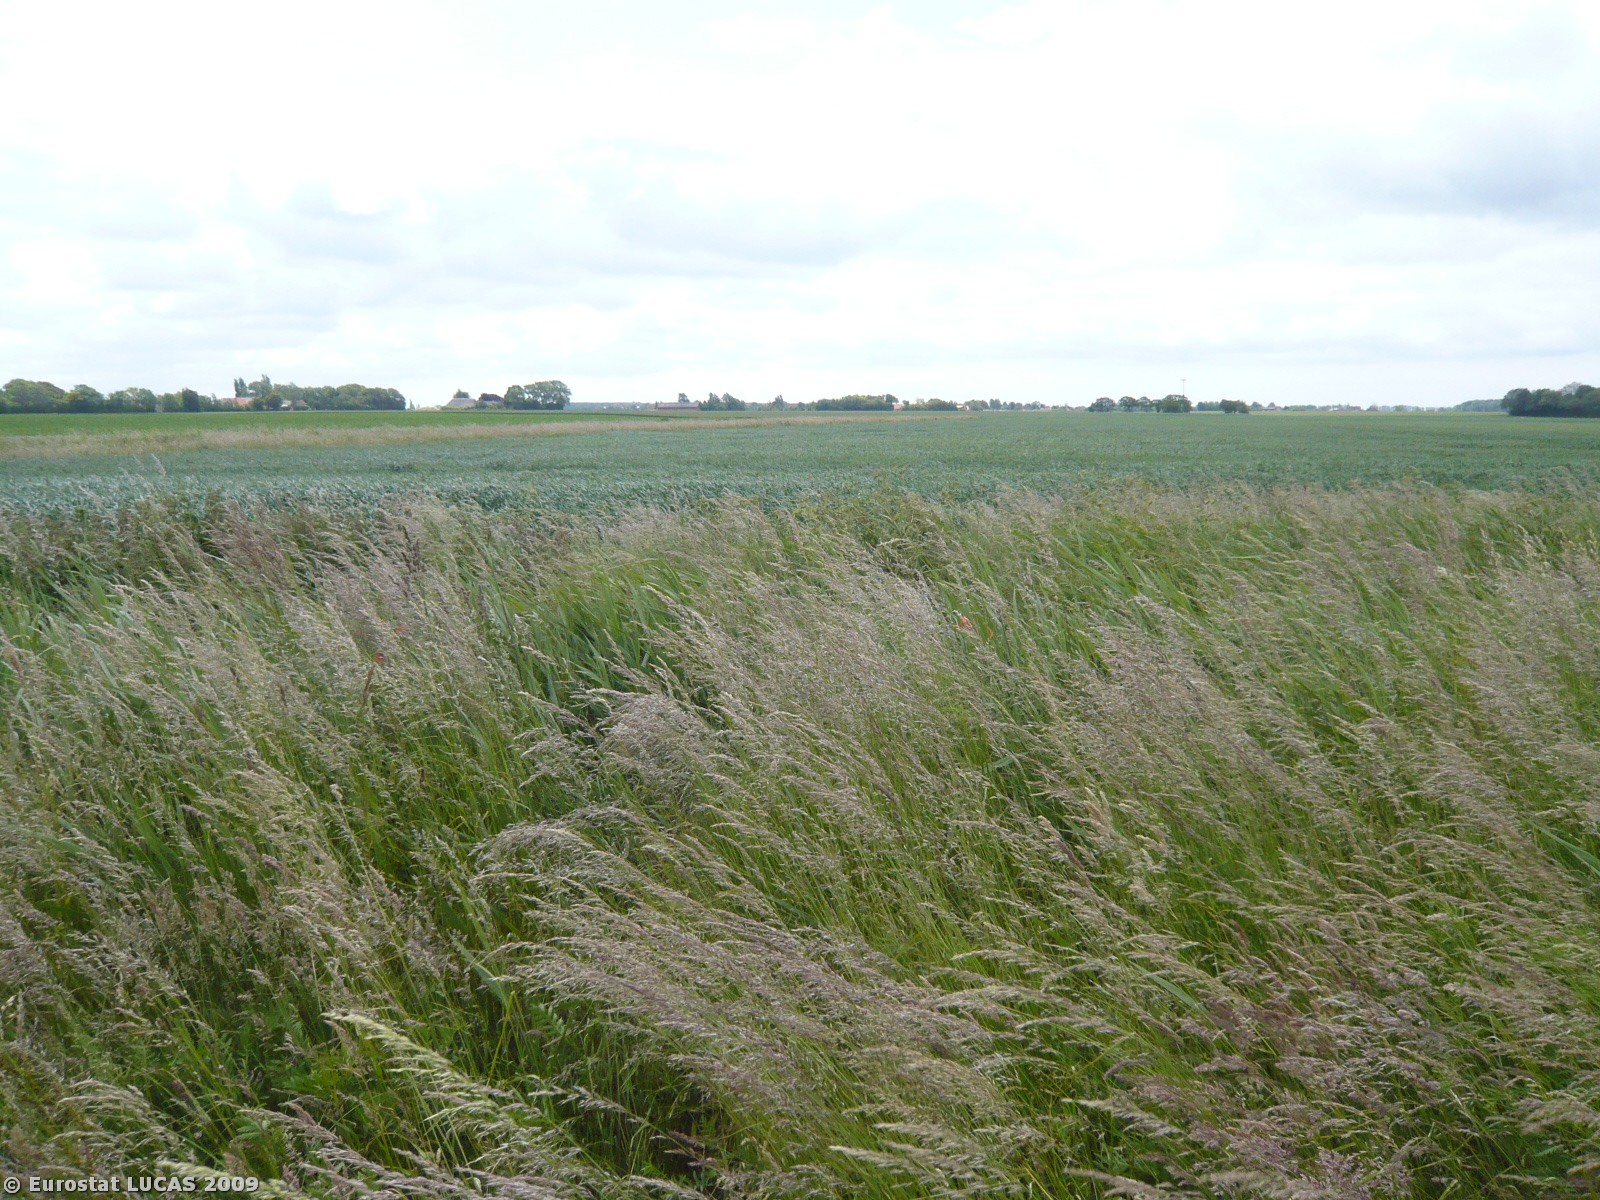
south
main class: Grassland
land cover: Grassland without tree/shrub cover
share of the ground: > 75 %
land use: Fallow land
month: June
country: DK
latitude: 54.9597
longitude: 11.2016
